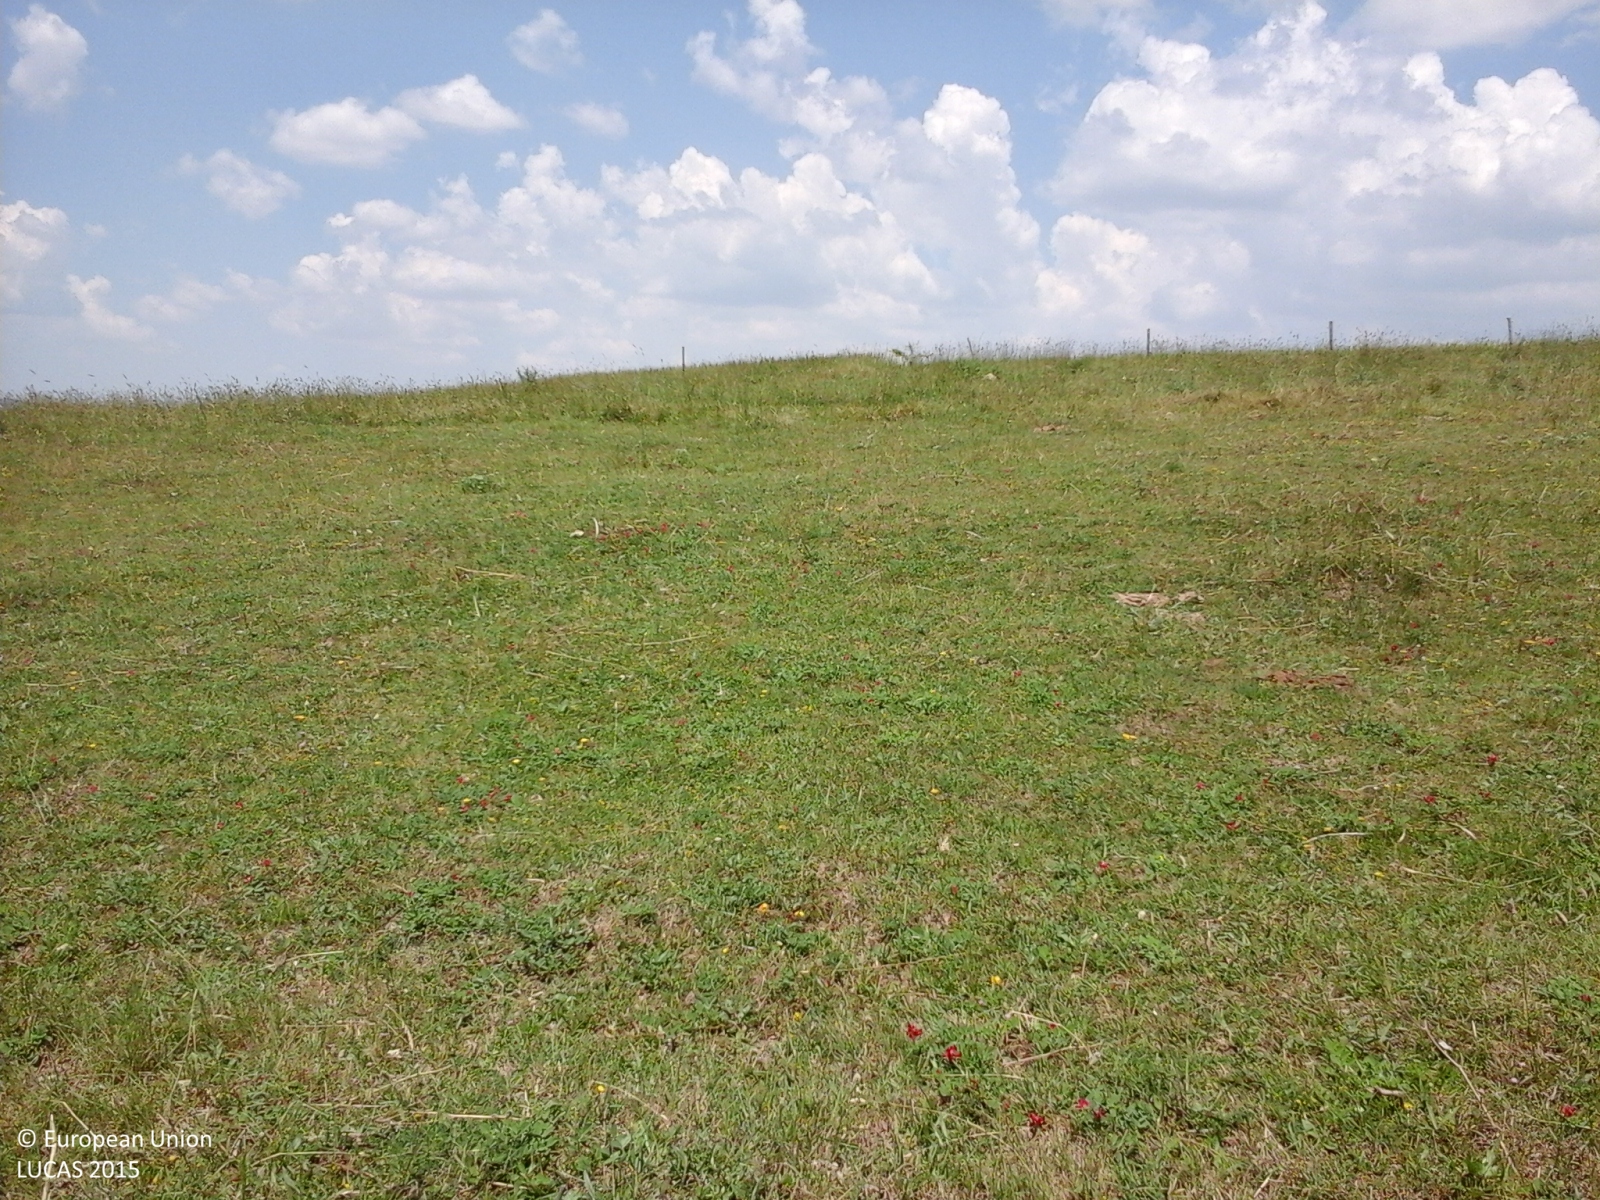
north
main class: Grassland
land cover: Grassland without tree/shrub cover
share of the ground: > 75 %
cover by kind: herbaceous plants 100 %
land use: Agriculture (excluding fallow land and kitchen gardens)
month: June
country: IT
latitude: 41.1463
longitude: 15.1641
